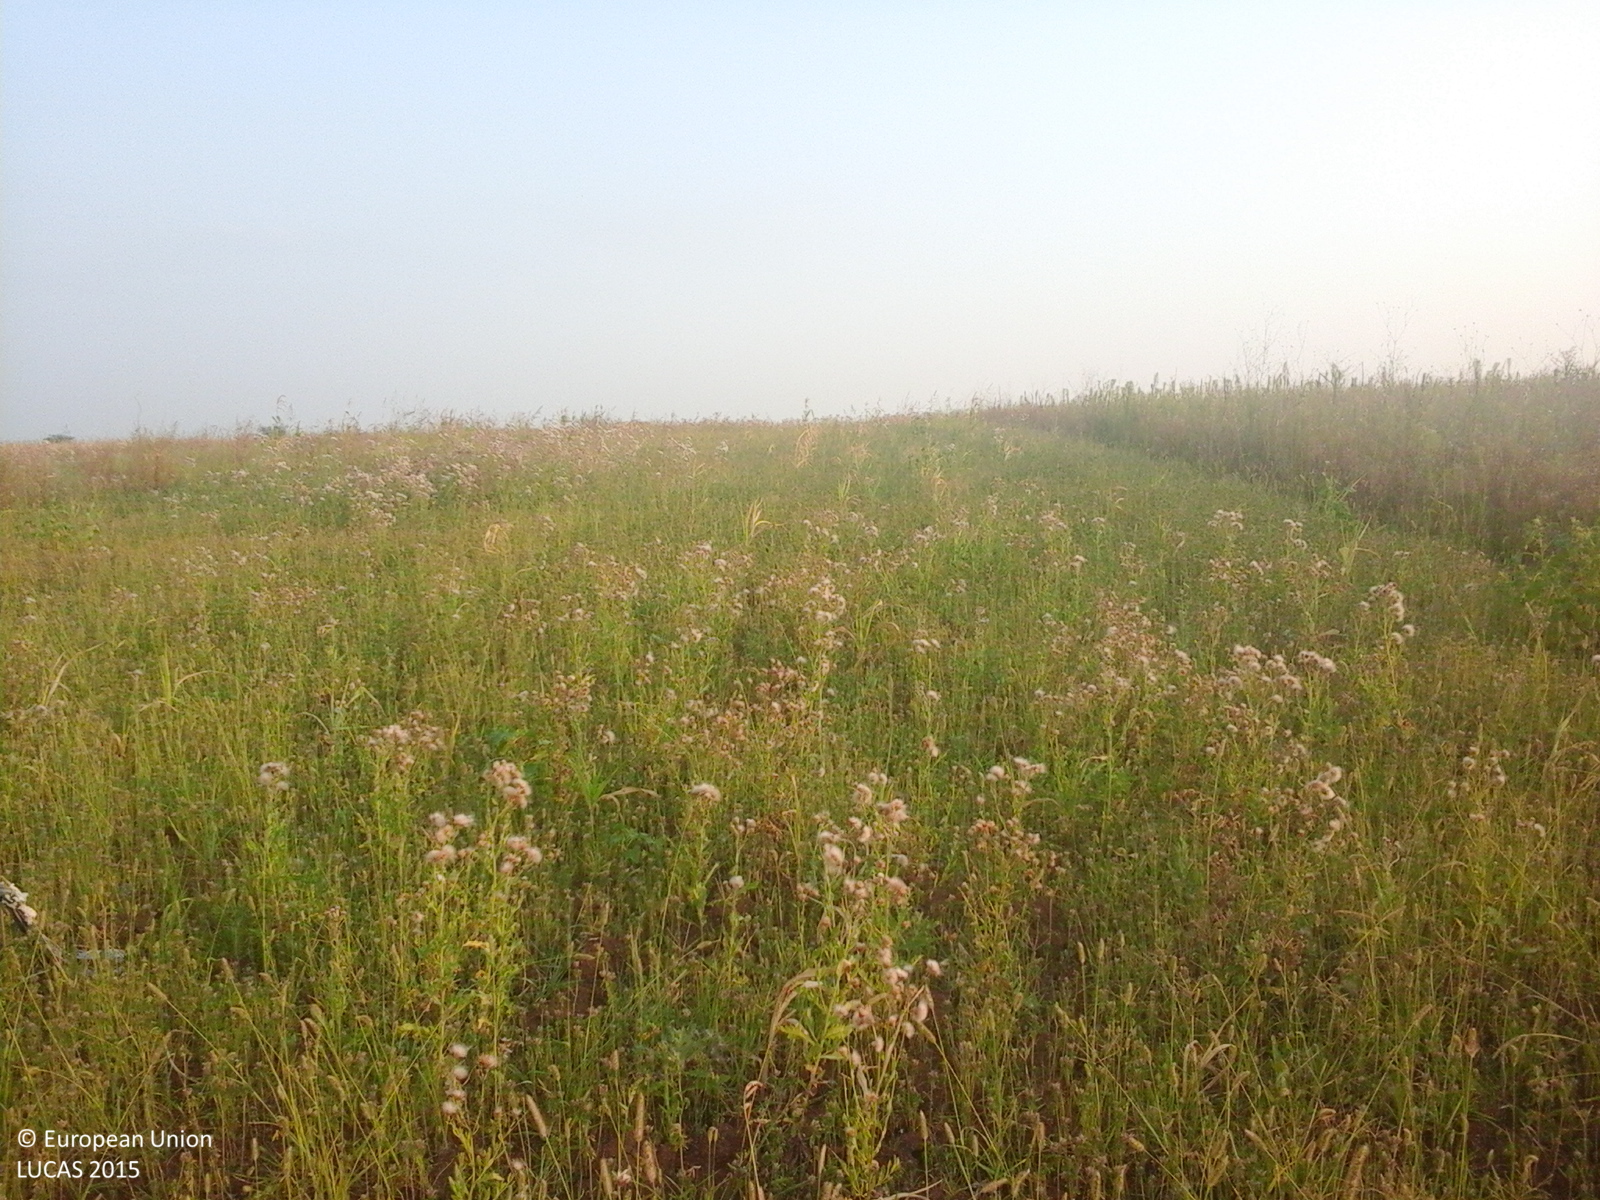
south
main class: Grassland
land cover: Spontaneously vegetated surfaces
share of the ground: > 75 %
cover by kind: herbaceous plants 100 %
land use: Fallow land
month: August
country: RO
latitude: 44.2311
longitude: 23.6370
